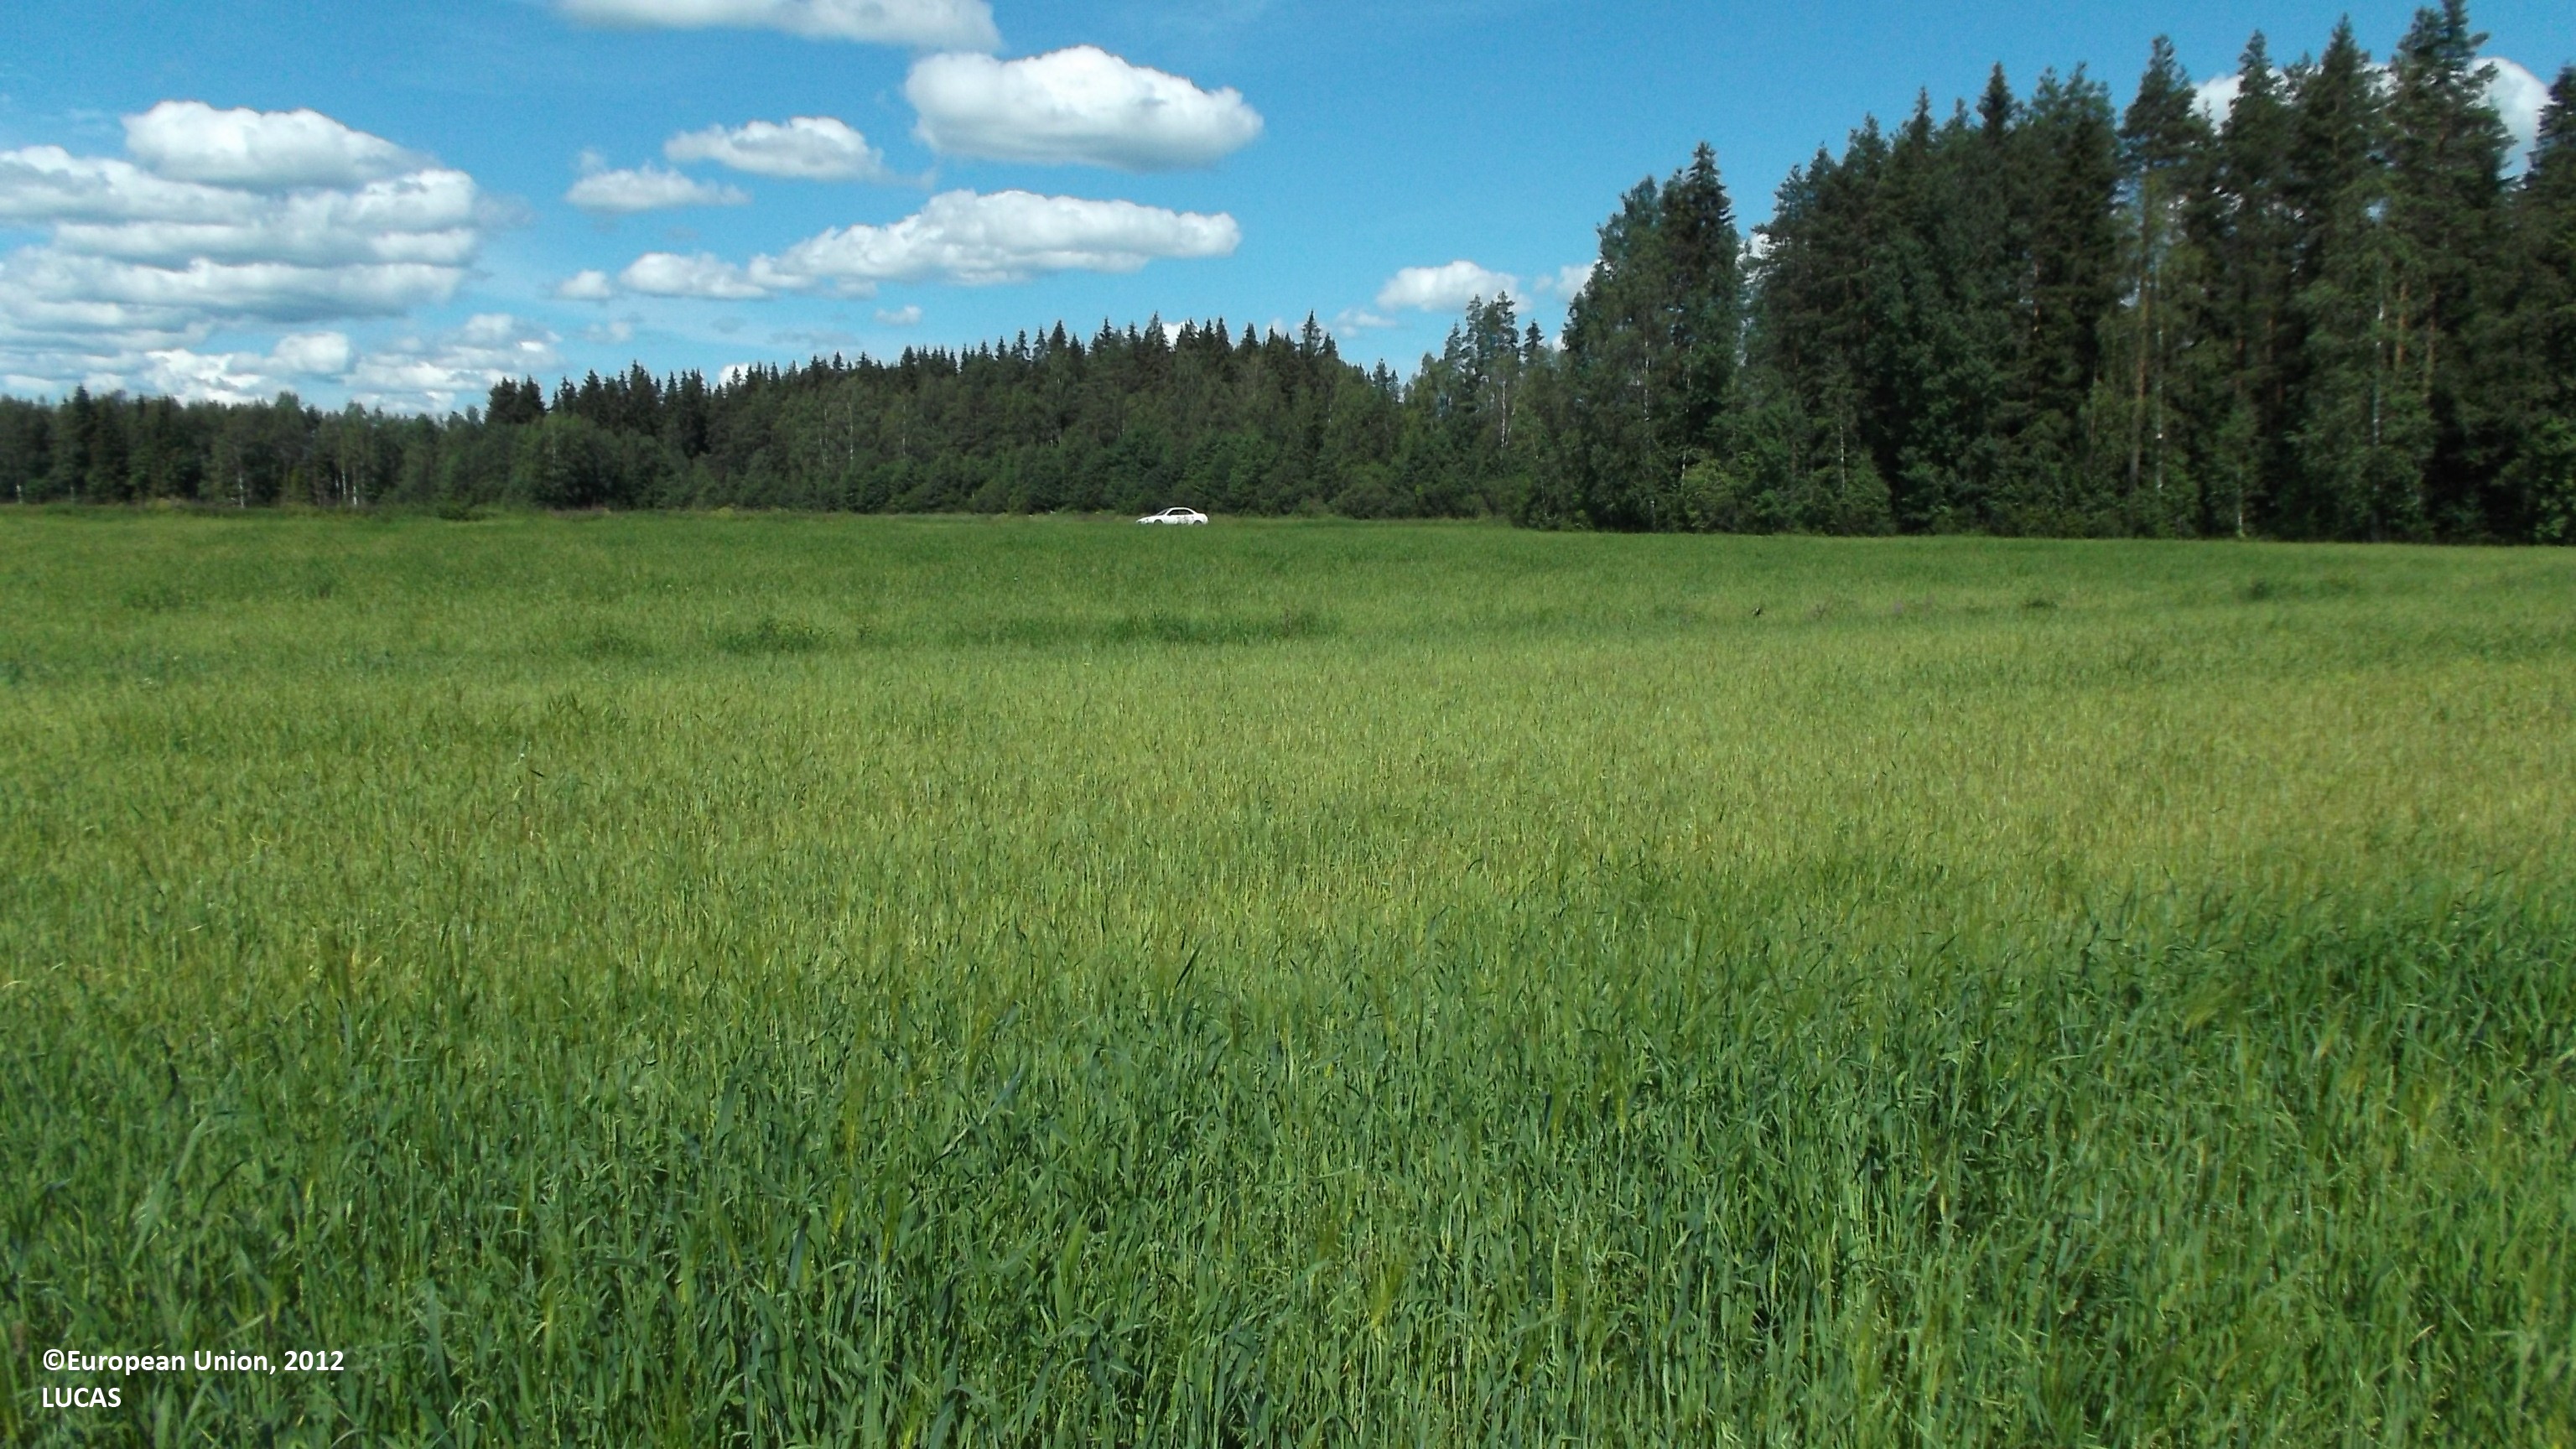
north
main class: Grassland
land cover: Grassland without tree/shrub cover
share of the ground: 25 - 50 %
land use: Fallow land
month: July
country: FI
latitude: 63.3259
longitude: 23.8667
